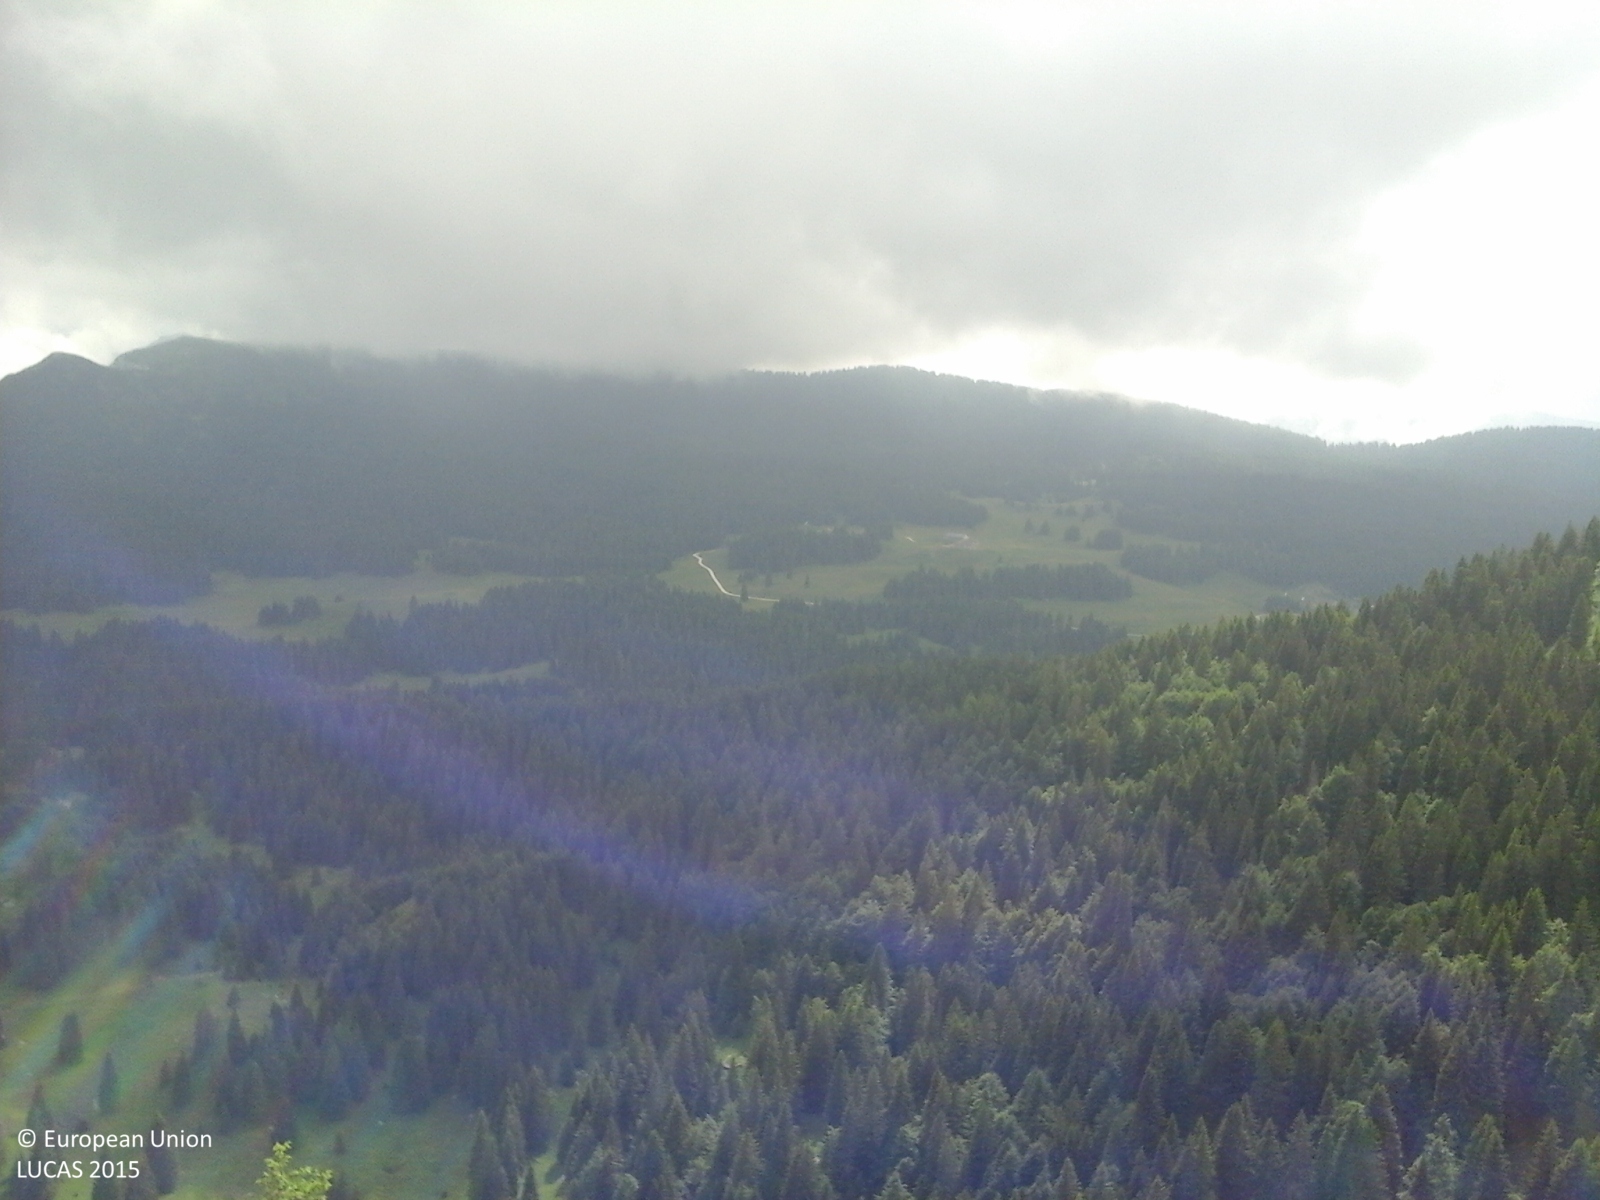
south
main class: Grassland
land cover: Grassland with sparse tree/shrub cover
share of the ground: > 75 %
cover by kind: herbaceous plants 95 %, coniferous forest trees 5 %
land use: Semi-natural and natural areas not in use
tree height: < 5 m
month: June
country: IT
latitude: 45.8755
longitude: 11.2478
